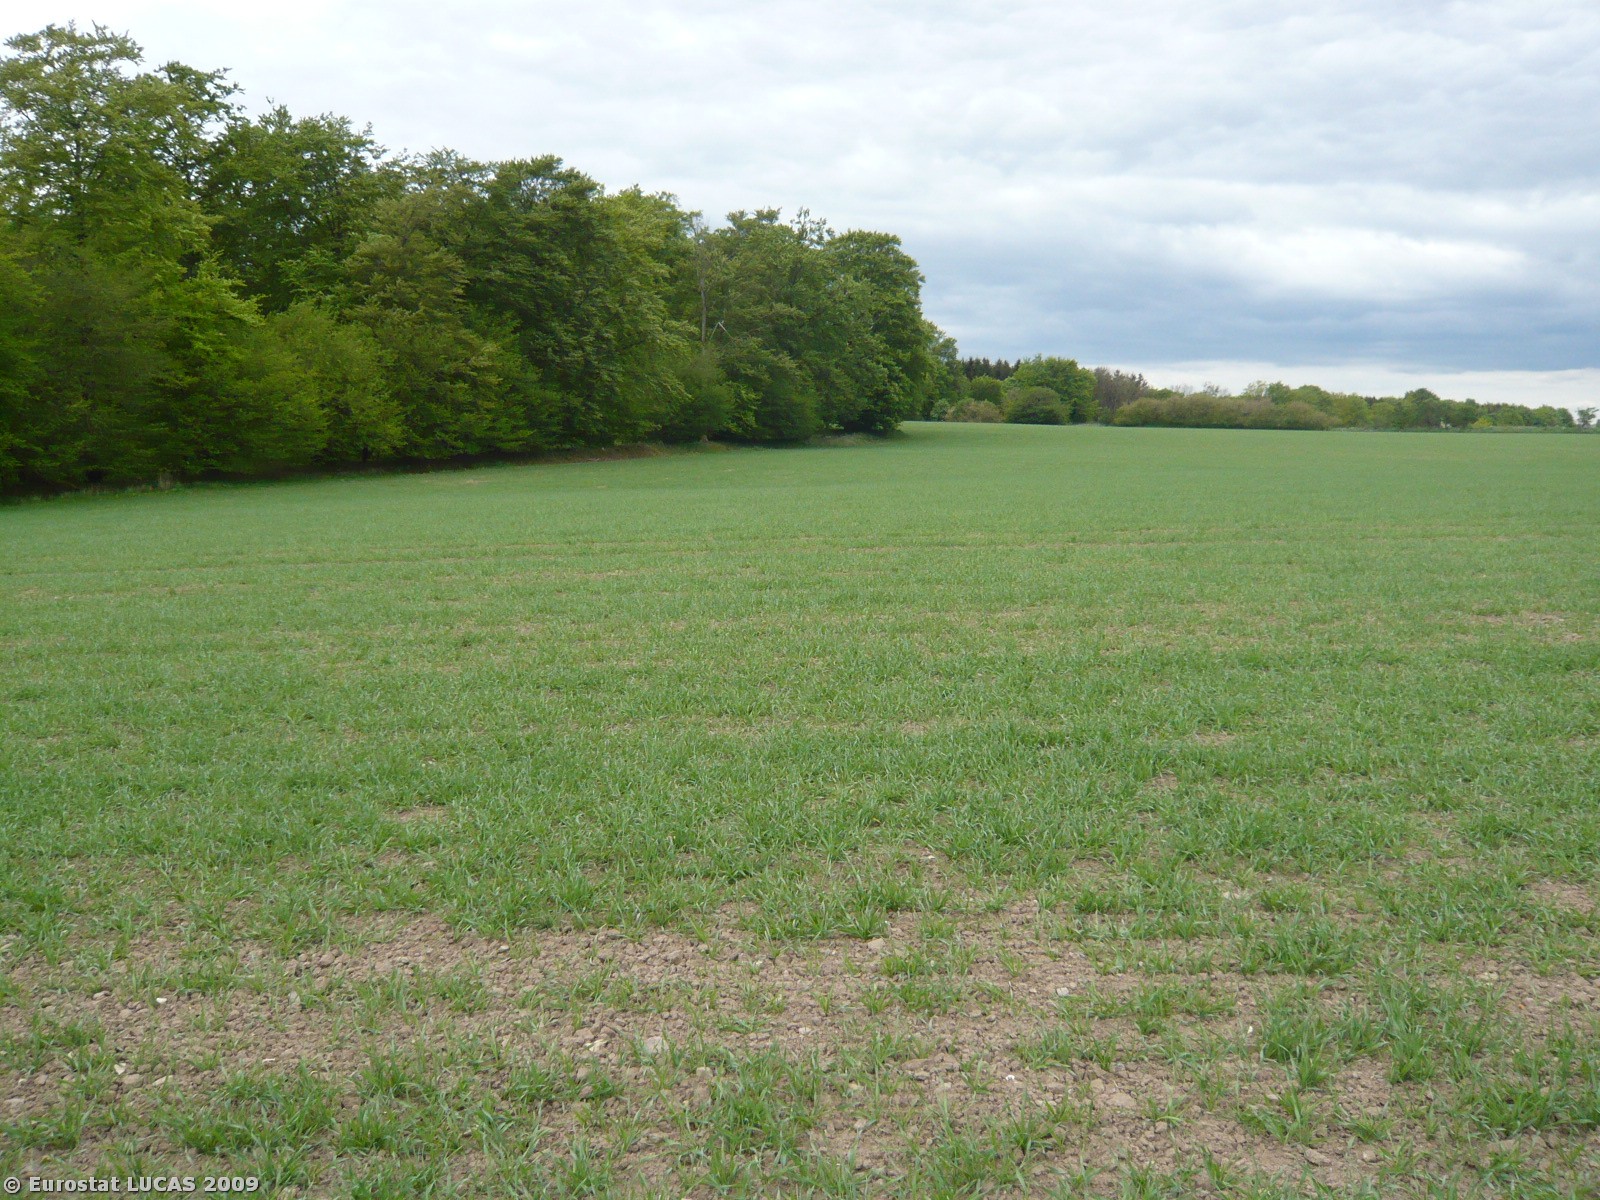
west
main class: Cropland
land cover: Common wheat
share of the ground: 25 - 50 %
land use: Agriculture (excluding fallow land and kitchen gardens)
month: May
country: DK
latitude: 55.0940
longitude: 11.9573
